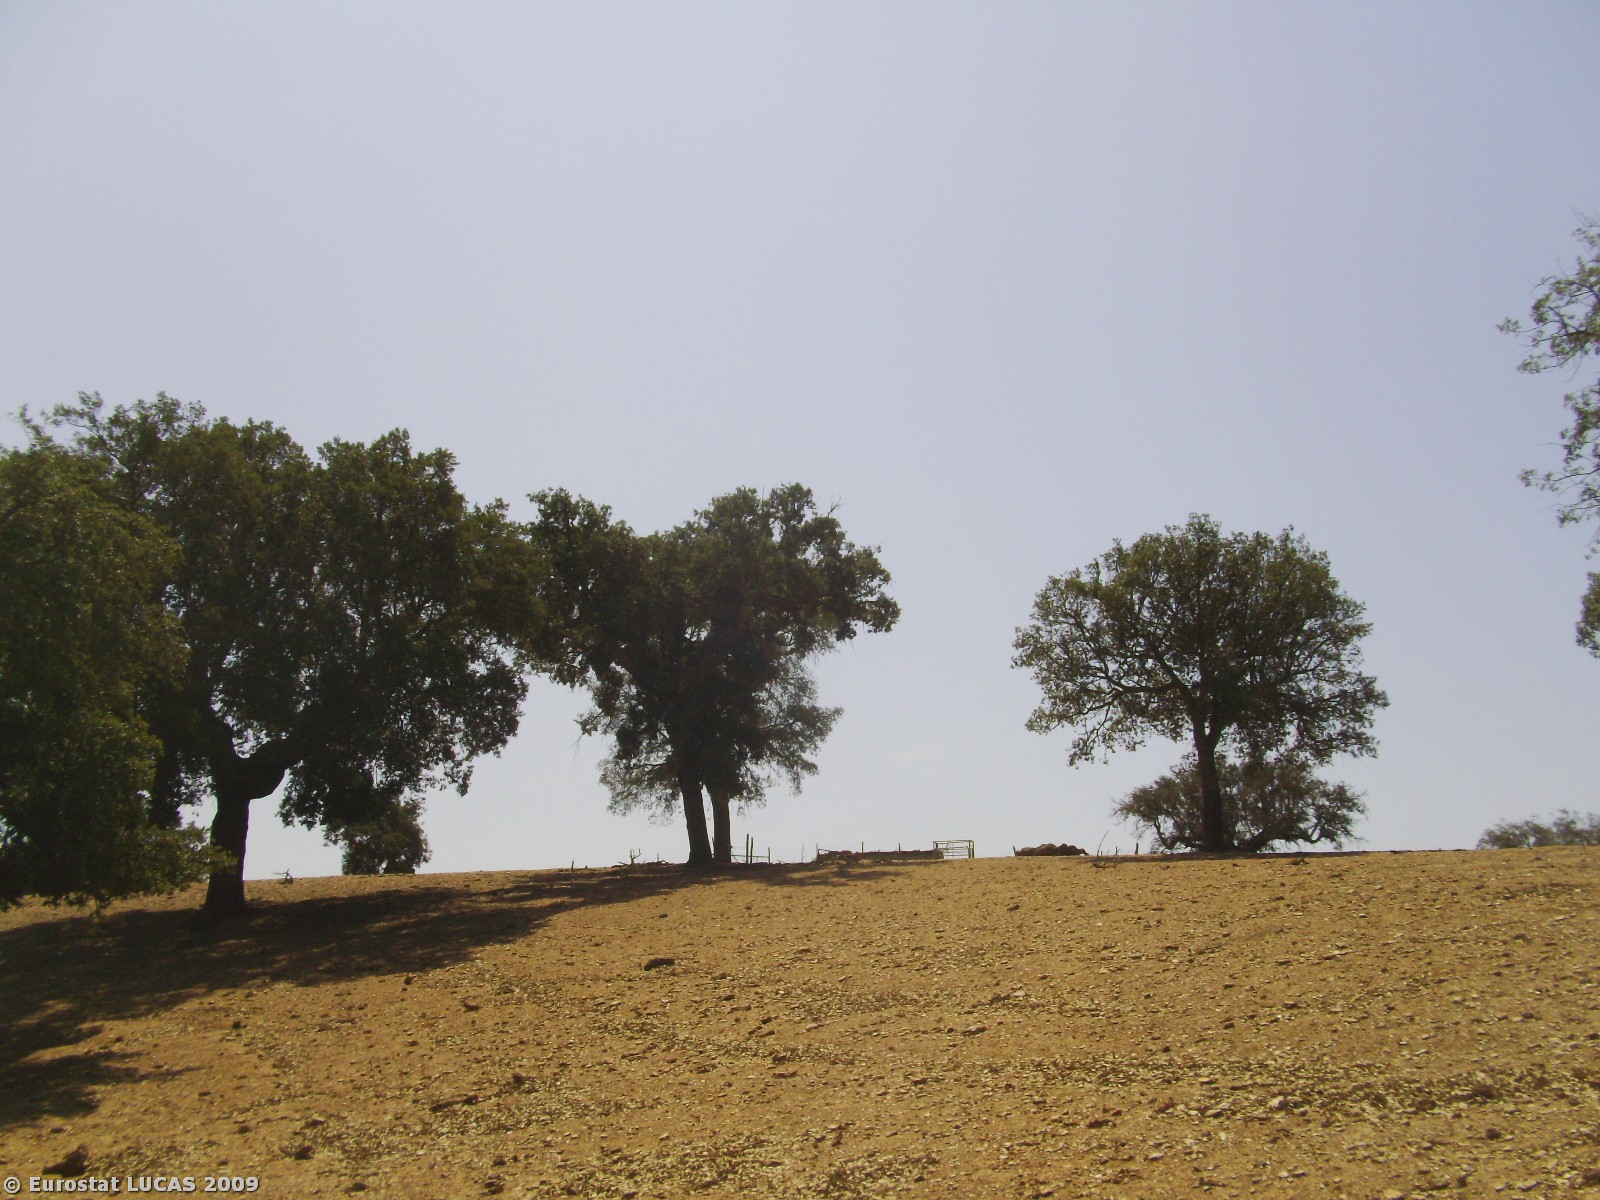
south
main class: Woodland
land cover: Broadleaved woodland
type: broadleaved evergreen forest
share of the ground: 10 - 25 %
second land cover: Bare land
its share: > 75 %
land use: Forestry
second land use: Agriculture (excluding fallow land and kitchen gardens)
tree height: > 5 m
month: August
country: PT
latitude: 38.3646
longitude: -7.8072
